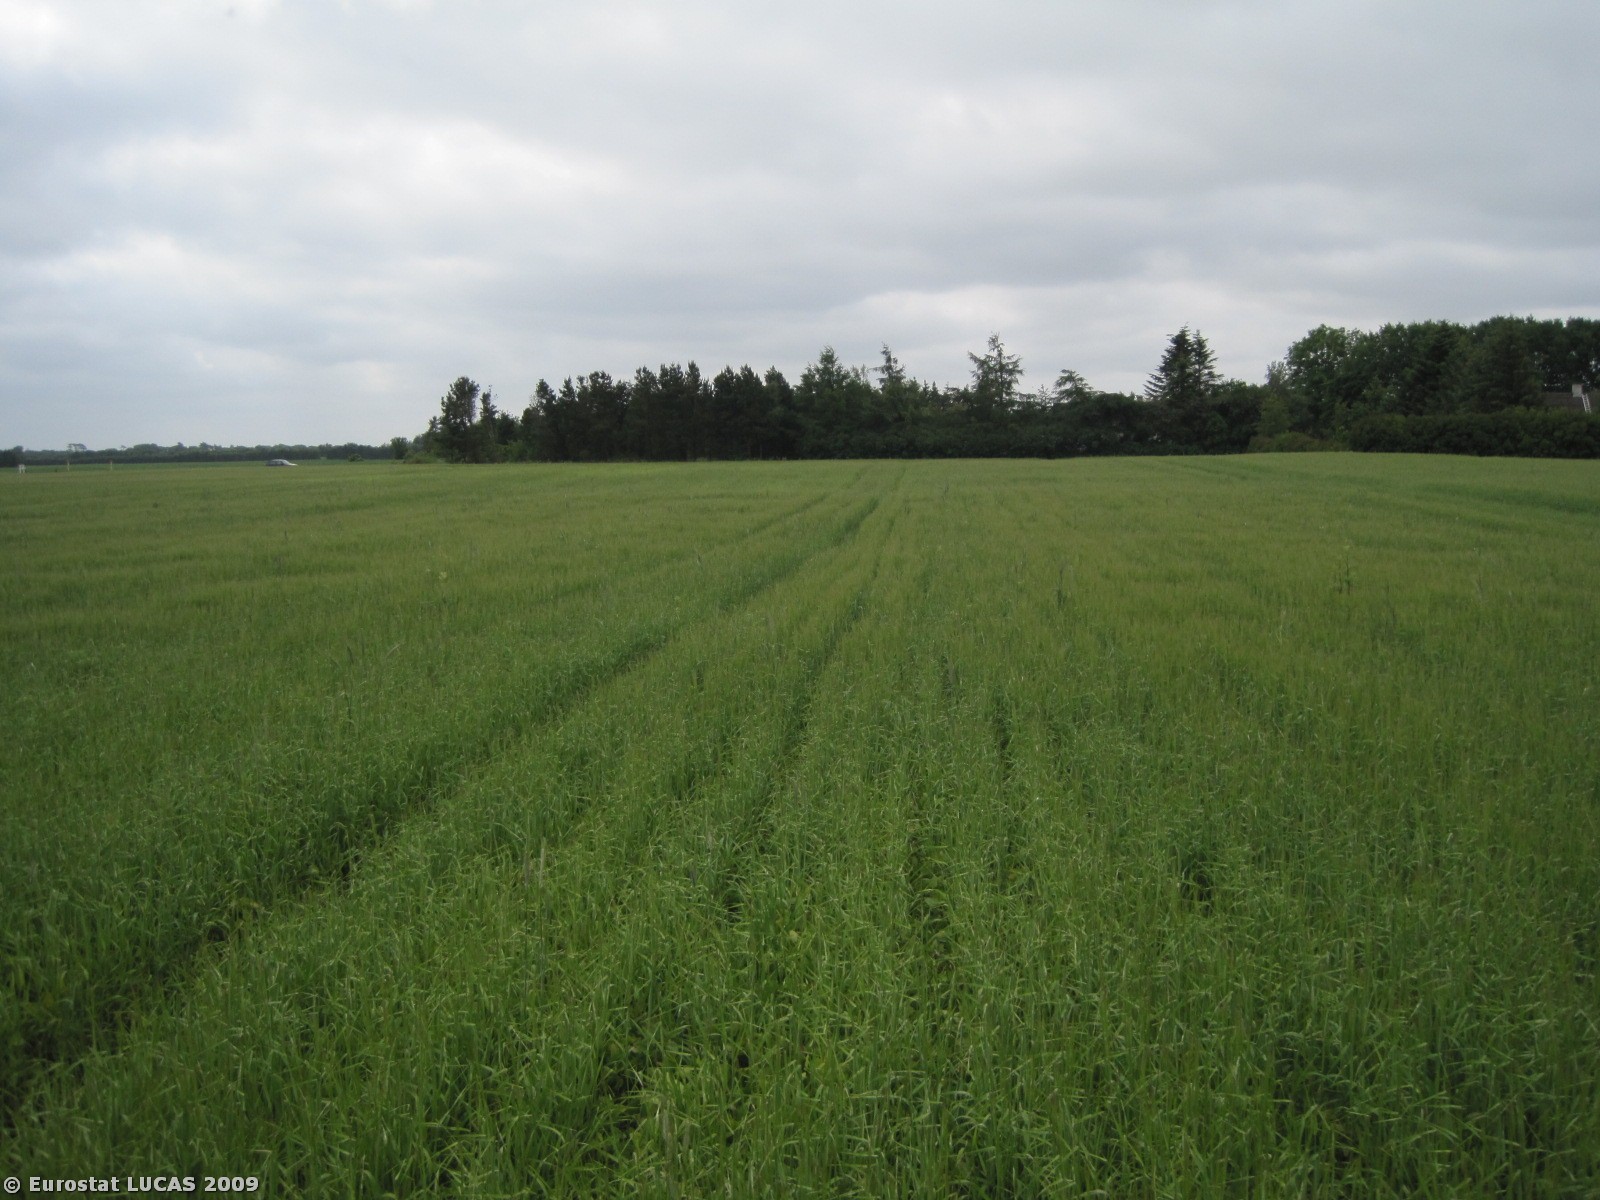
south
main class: Cropland
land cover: Barley
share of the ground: > 75 %
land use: Agriculture (excluding fallow land and kitchen gardens)
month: June
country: DK
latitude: 57.1944
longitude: 10.0826
